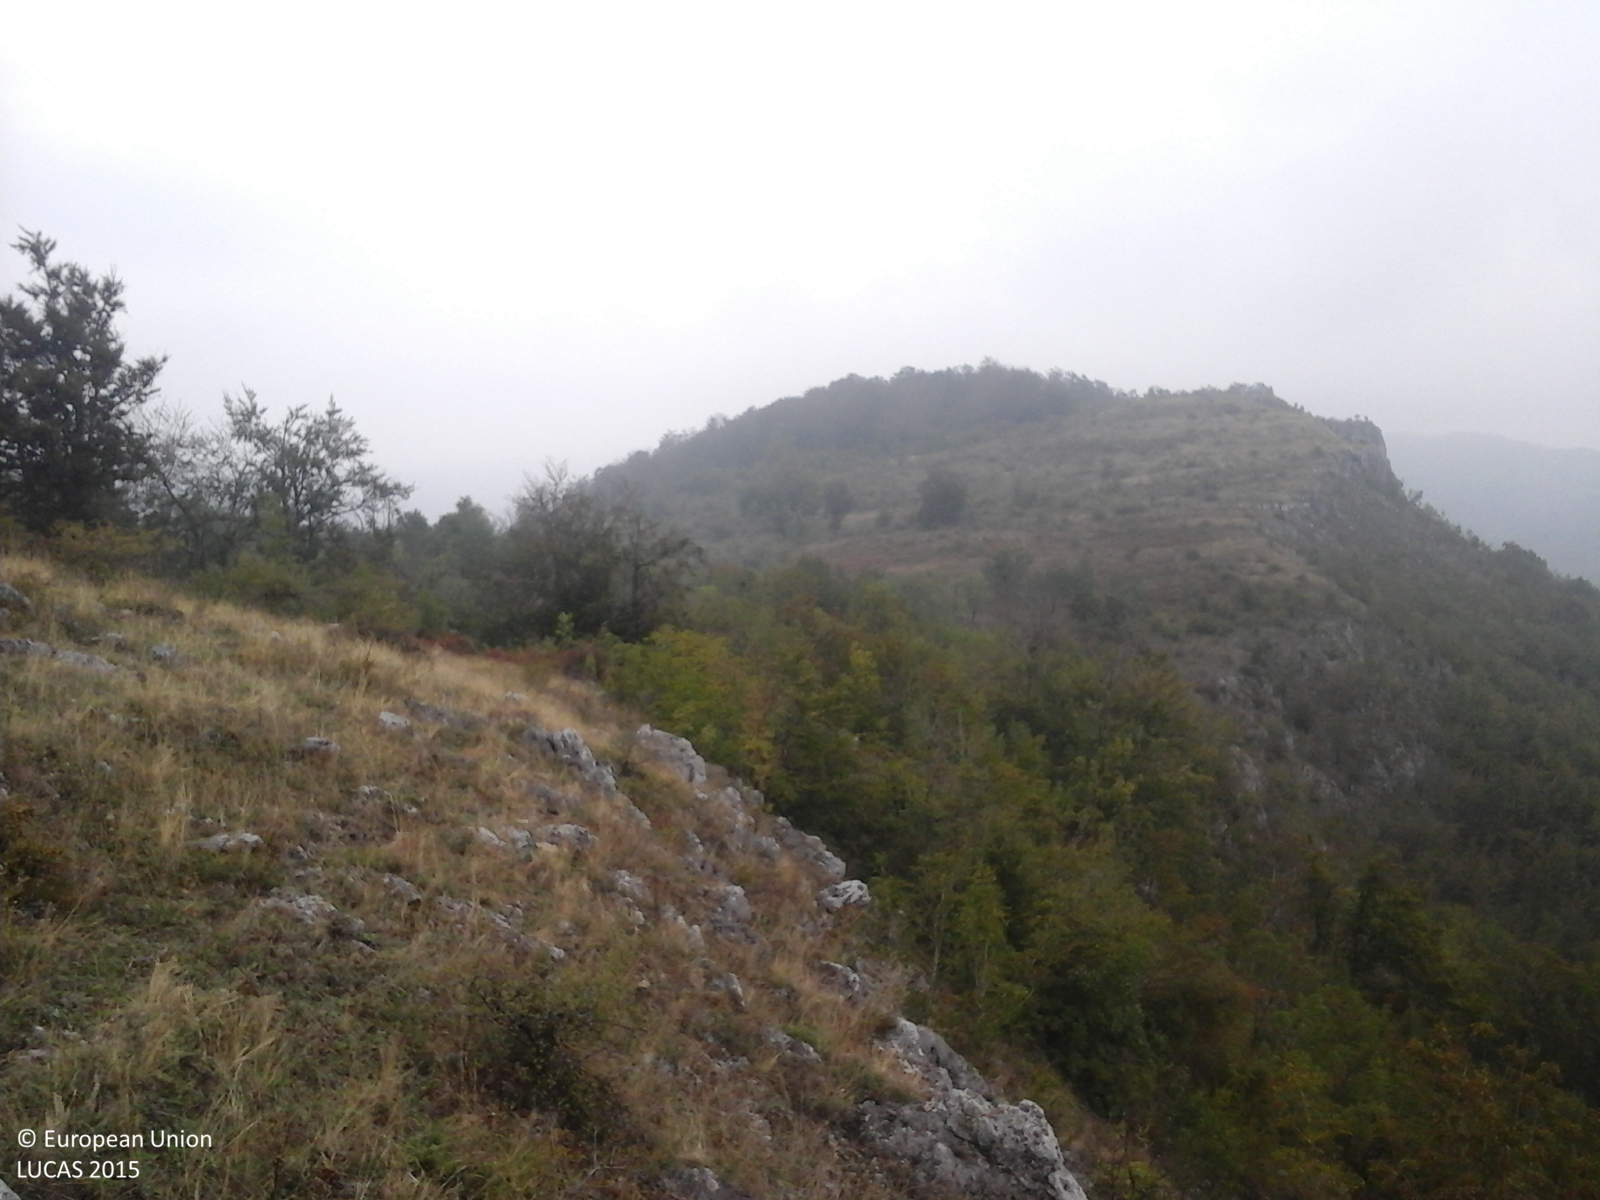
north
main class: Shrubland
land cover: Shrubland without tree cover
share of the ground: > 75 %
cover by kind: shrubs 90 %, herbaceous plants 10 %
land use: Semi-natural and natural areas not in use
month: September
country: RO
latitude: 45.0782
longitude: 22.8653
